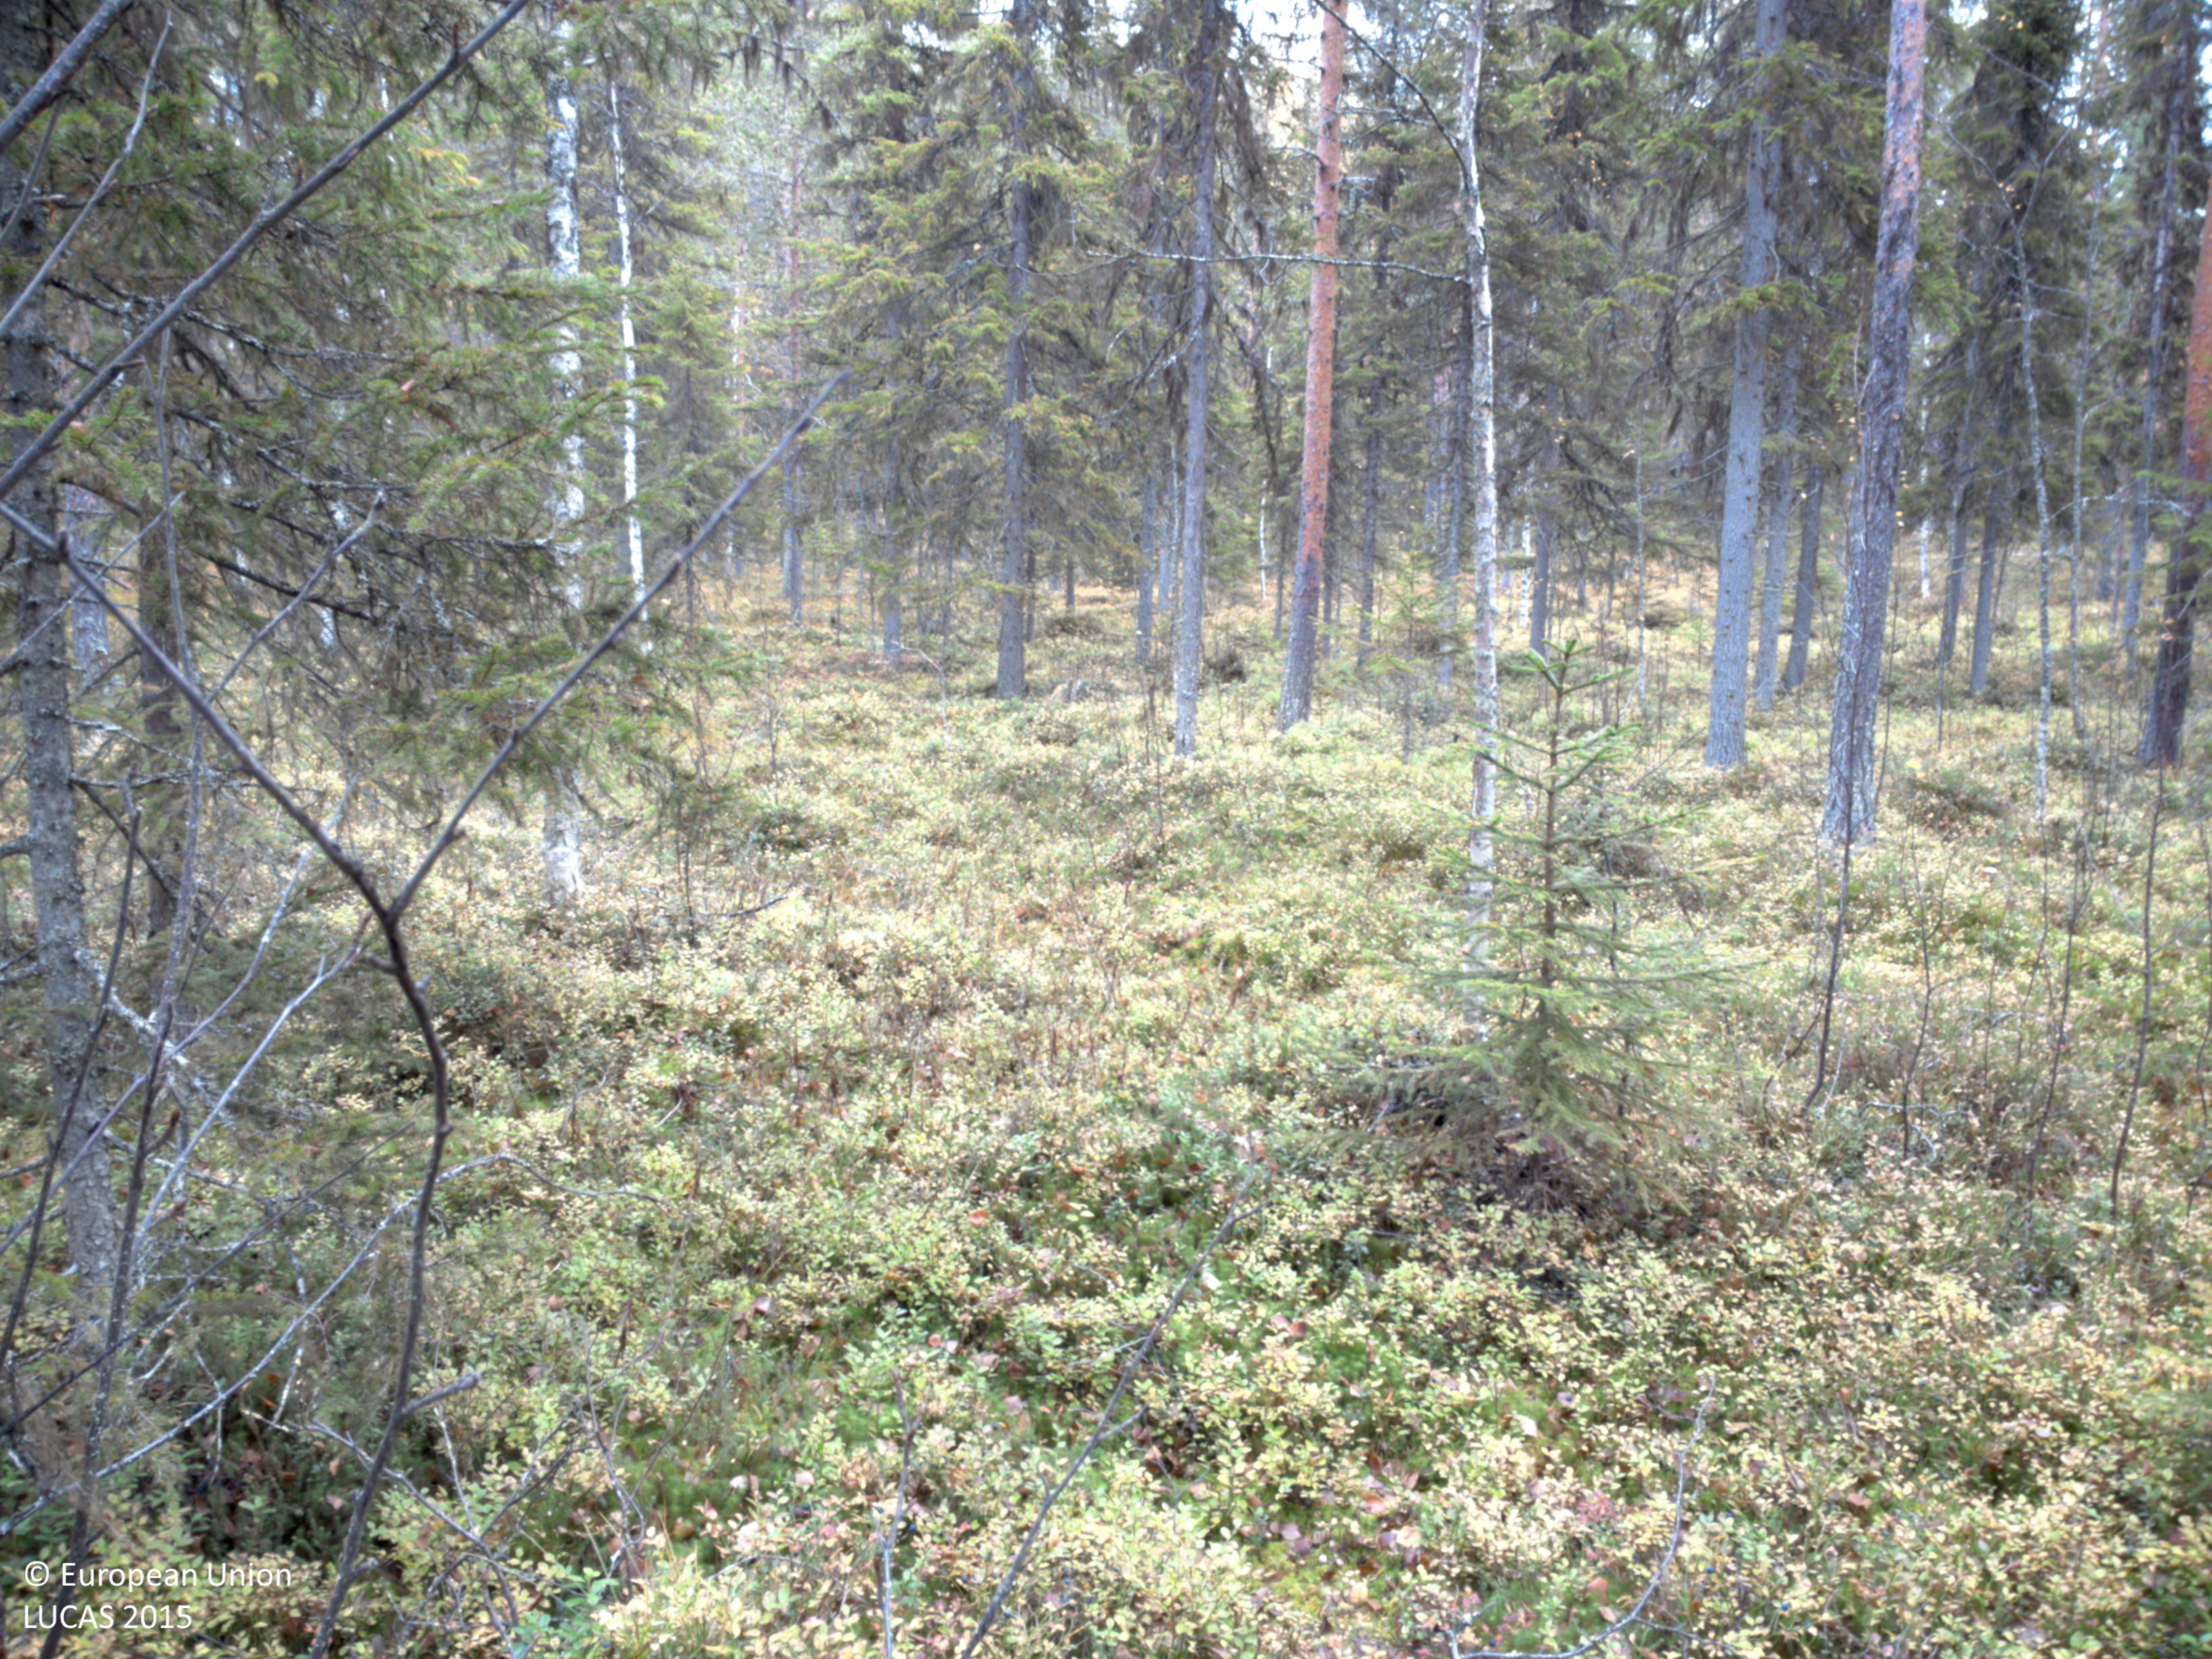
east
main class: Woodland
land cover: Spruce dominated coniferous woodland
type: boreal forest
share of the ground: > 75 %
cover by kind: coniferous forest trees 70 %, shrubs 20 %, broadleaved forest trees 5 %, lichens and mosses 5 %
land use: Forestry
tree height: > 5 m
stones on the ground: < 10 %
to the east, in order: Spruce dominated coniferous woodland; Pine dominated coniferous woodland; Spruce dominated coniferous woodland; Pine dominated coniferous woodland; Spruce dominated coniferous woodland; Spruce dominated mixed woodland
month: October
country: SE
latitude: 64.9494
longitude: 18.1981
